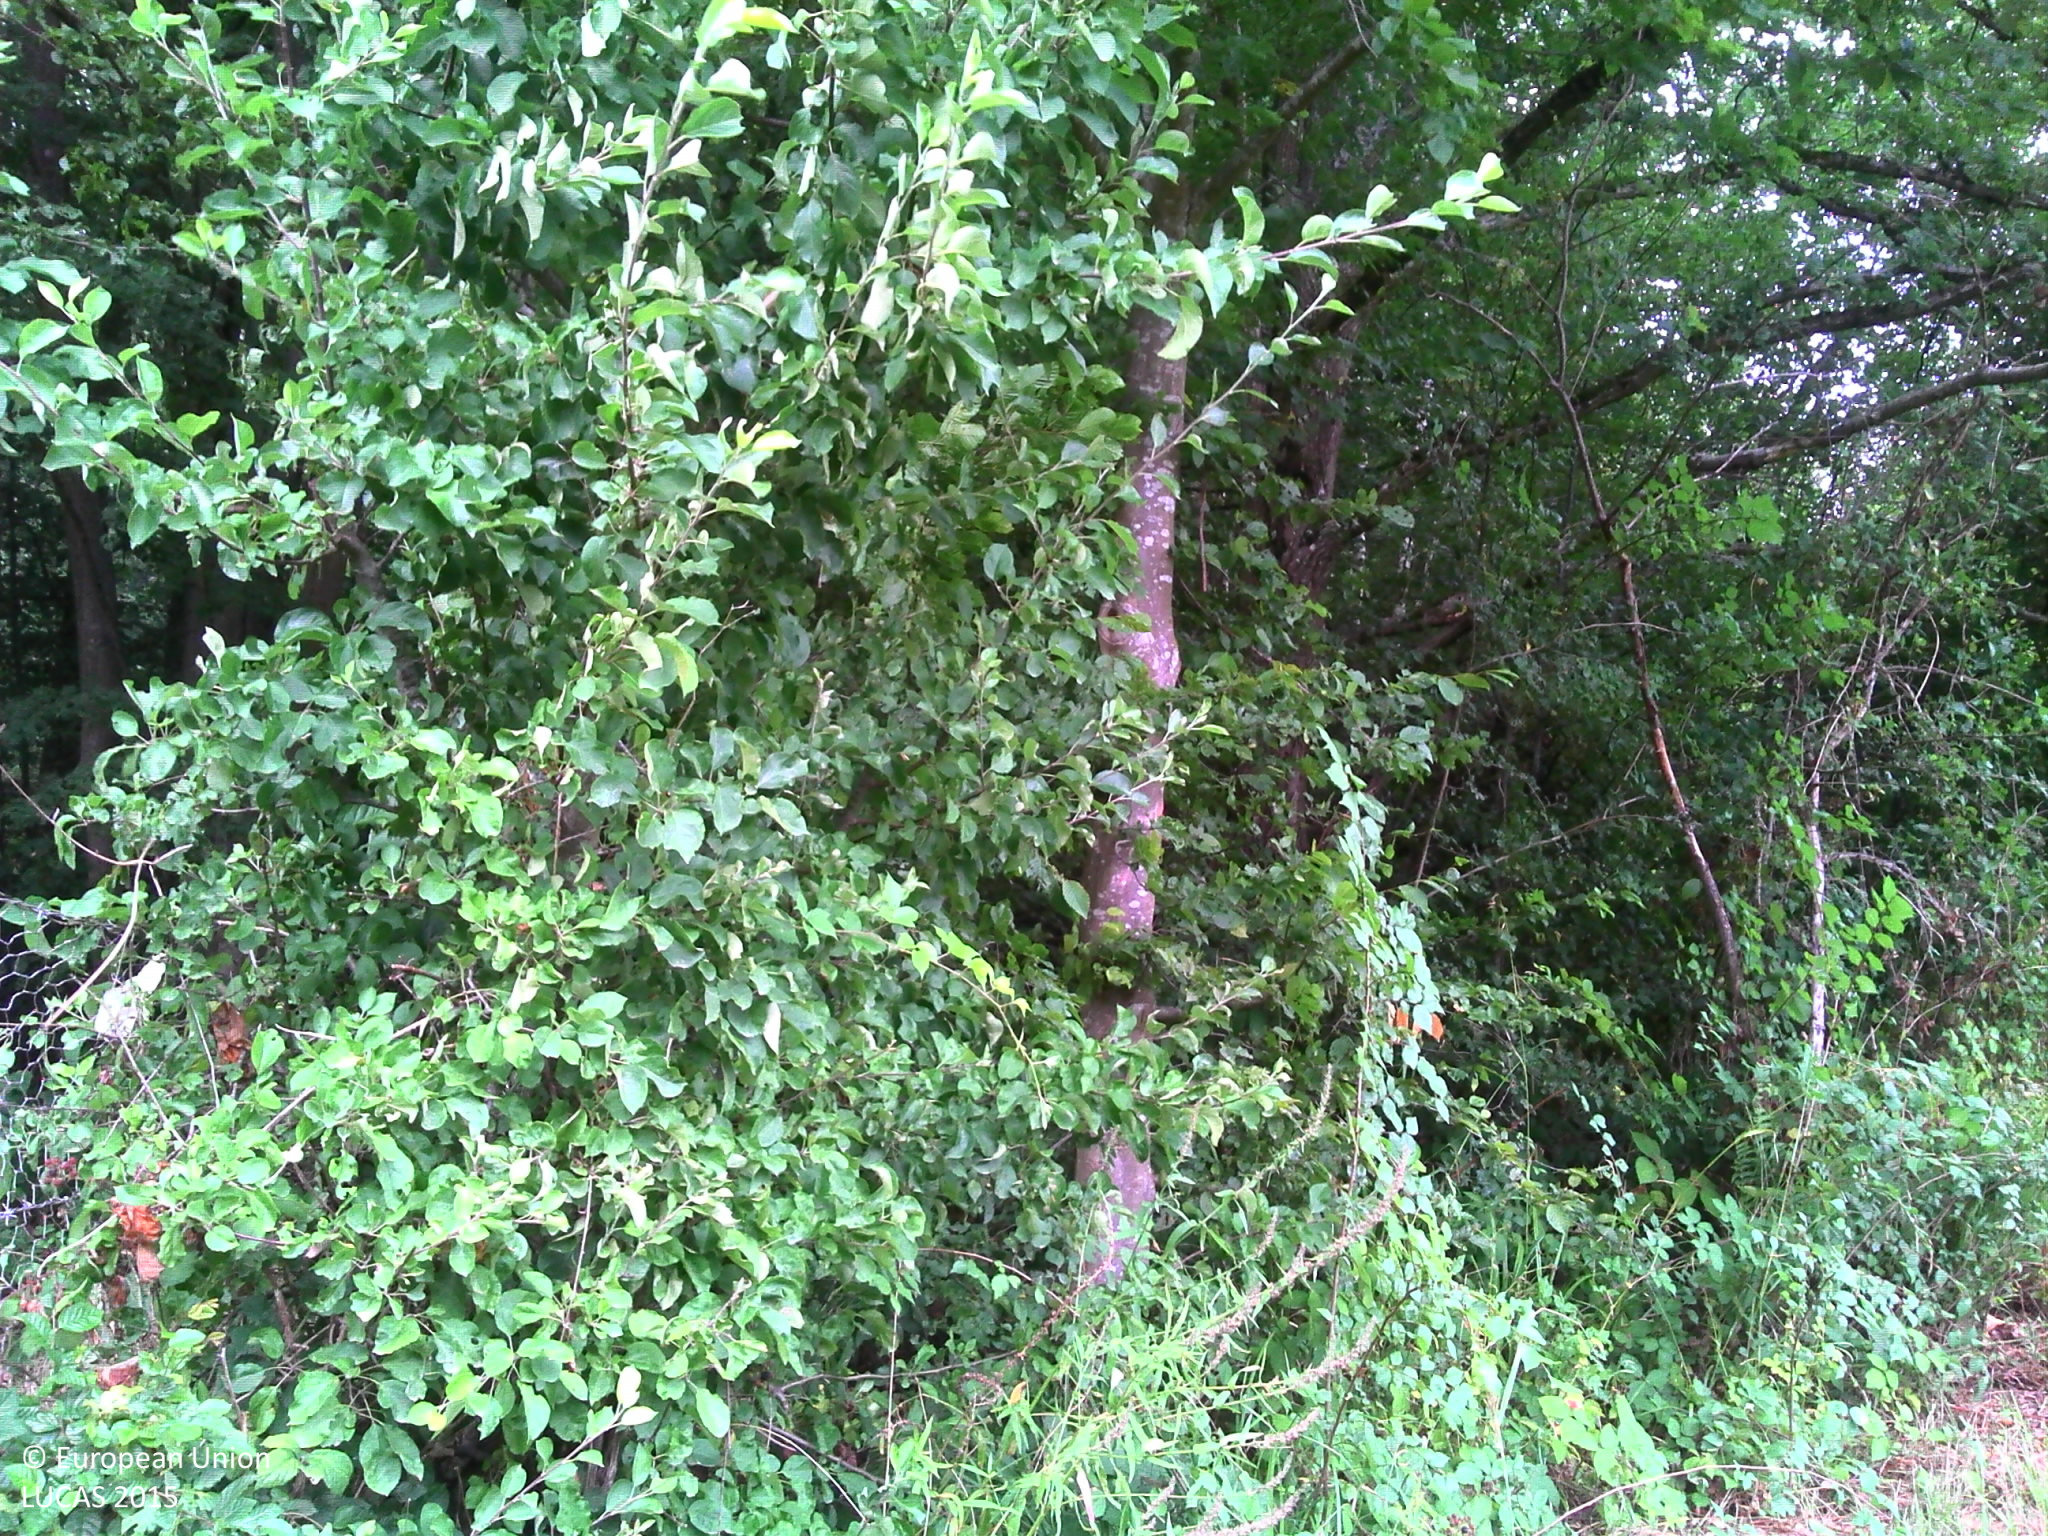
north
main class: Woodland
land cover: Broadleaved woodland
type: acidophilous oak and oak-birch forest
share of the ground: > 75 %
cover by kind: broadleaved forest trees 100 %
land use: Forestry
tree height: > 5 m
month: July
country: FR
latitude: 48.7214
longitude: 2.6905
